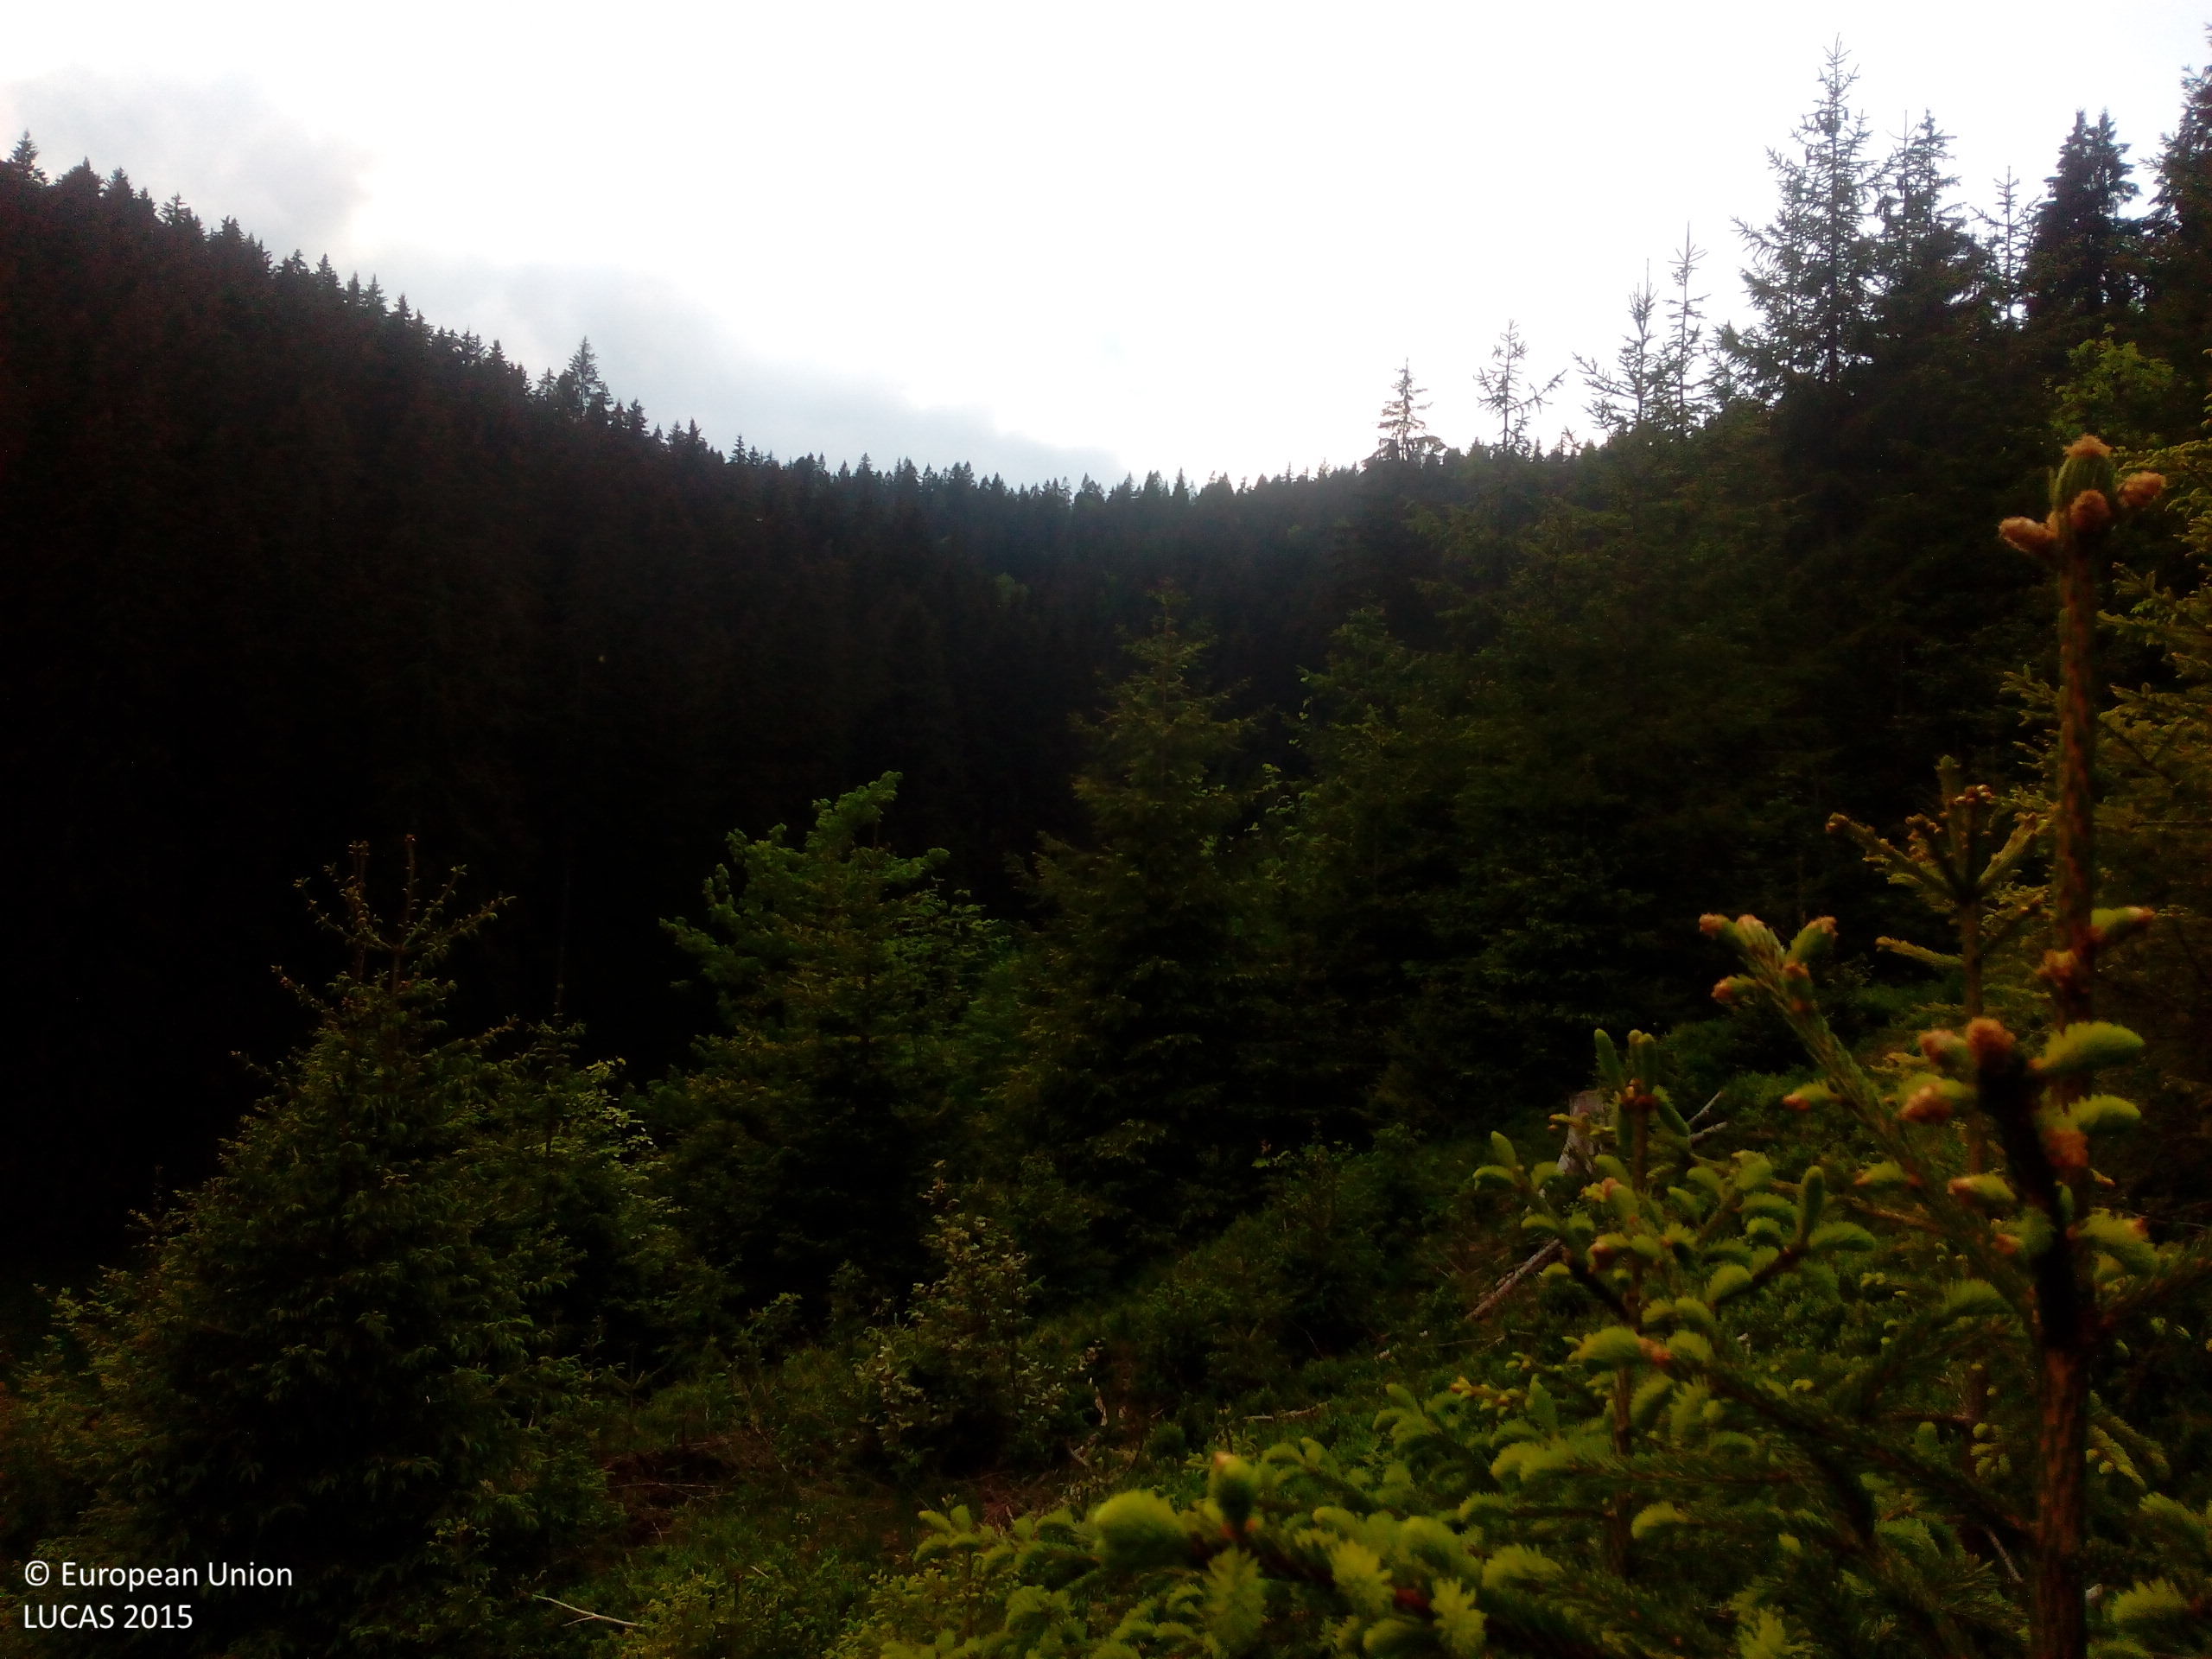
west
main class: Woodland
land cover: Spruce dominated coniferous woodland
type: hemiboreal forest and nemoral coniferous forest and mixed broadleaved-coniferous forest
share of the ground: 25 - 50 %
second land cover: Shrubland without tree cover
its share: 50 - 75 %
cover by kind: coniferous forest trees 40 %, shrubs 40 %, herbaceous plants 20 %
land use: Forestry
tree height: < 5 m
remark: Clear cut
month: May
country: DE
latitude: 48.0647
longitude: 8.1894
